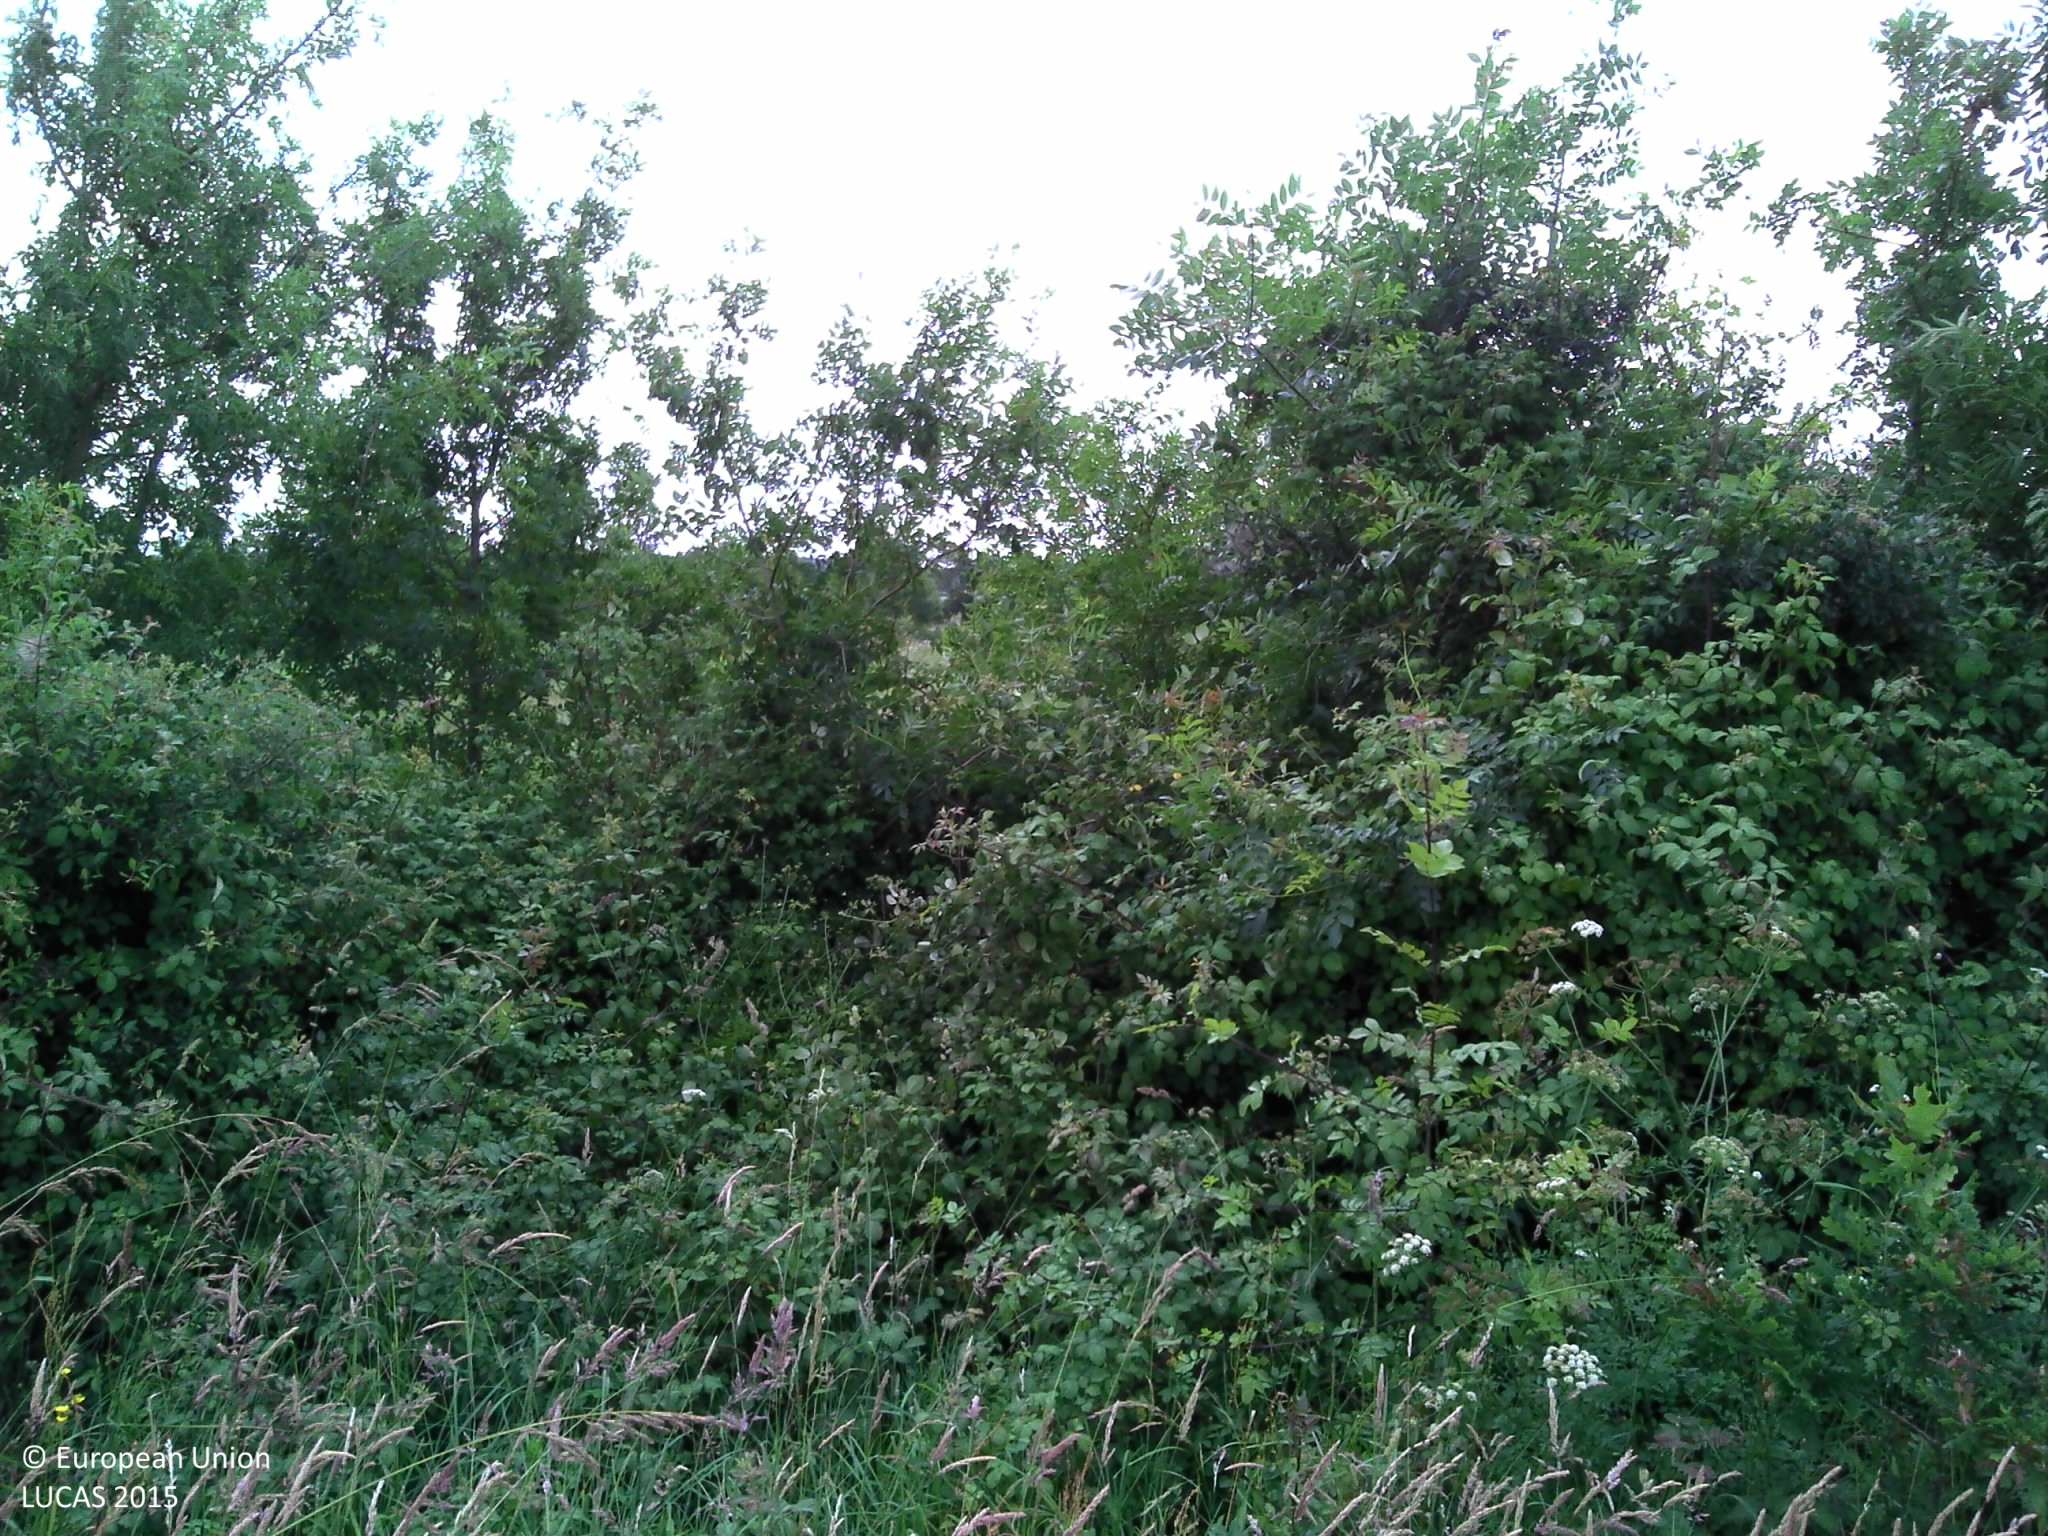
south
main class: Grassland
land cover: Grassland without tree/shrub cover
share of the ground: > 75 %
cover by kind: herbaceous plants 100 %
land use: Agriculture (excluding fallow land and kitchen gardens)
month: June
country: FR
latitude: 47.1253
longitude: -2.0305
